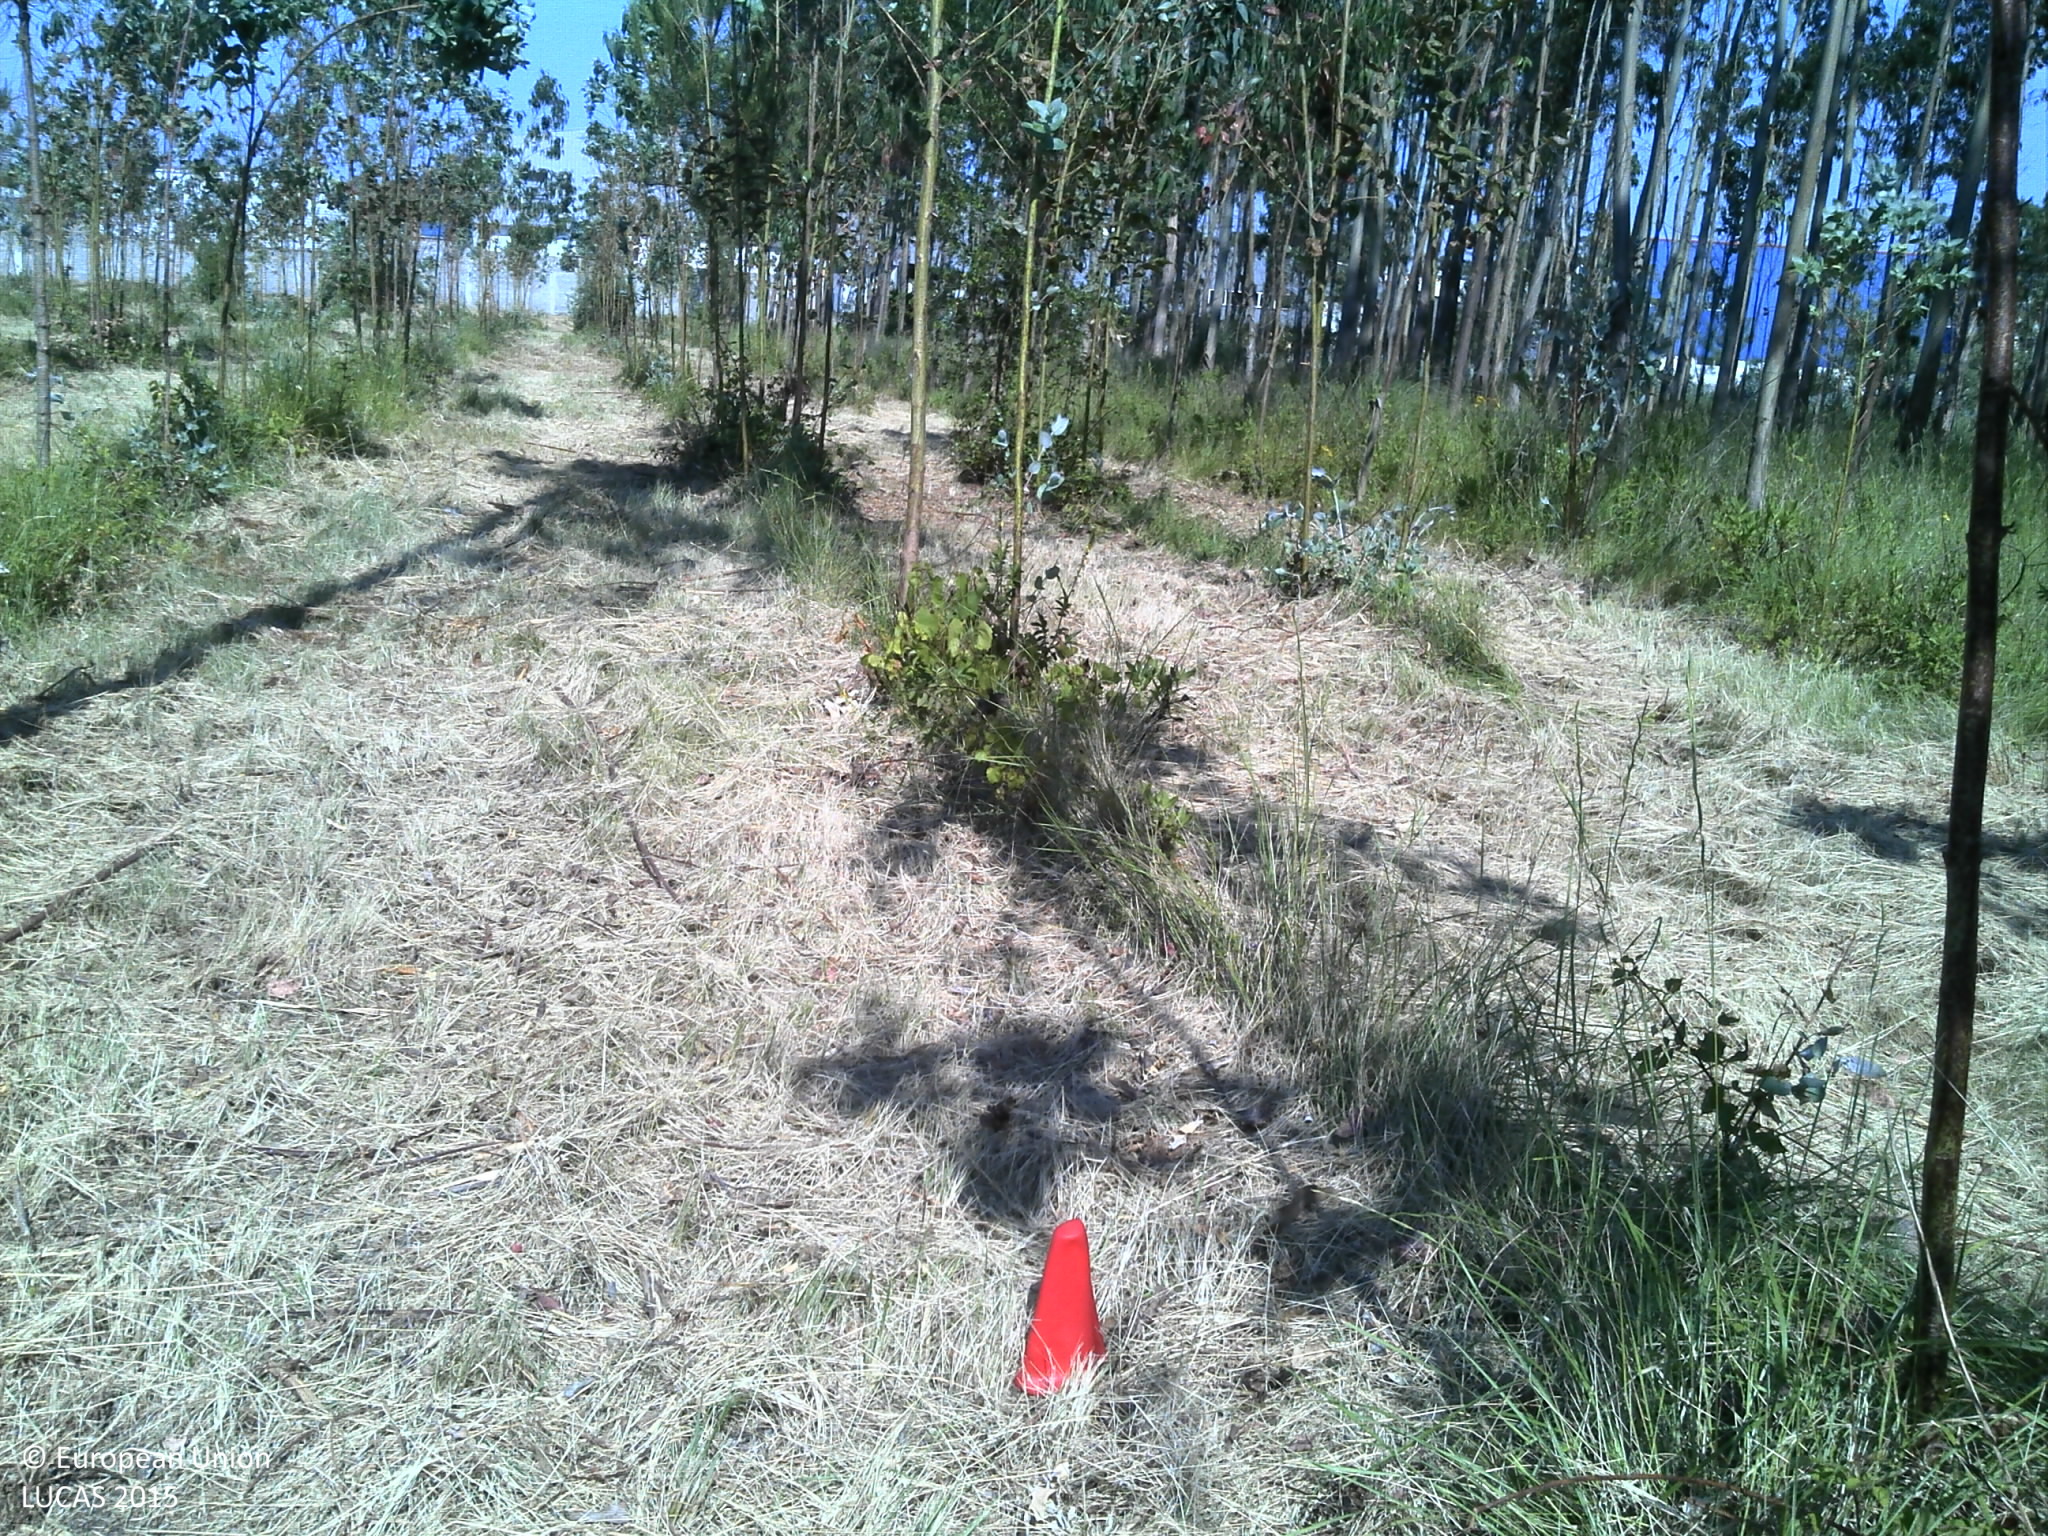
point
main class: Woodland
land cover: Broadleaved woodland
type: exotic forest
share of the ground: 25 - 50 %
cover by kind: broadleaved forest trees 50 %, unconsolidated bare surface 35 %, herbaceous plants 10 %, shrubs 5 %
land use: Forestry
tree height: < 5 m
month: June
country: PT
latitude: 40.3558
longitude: -8.6129
